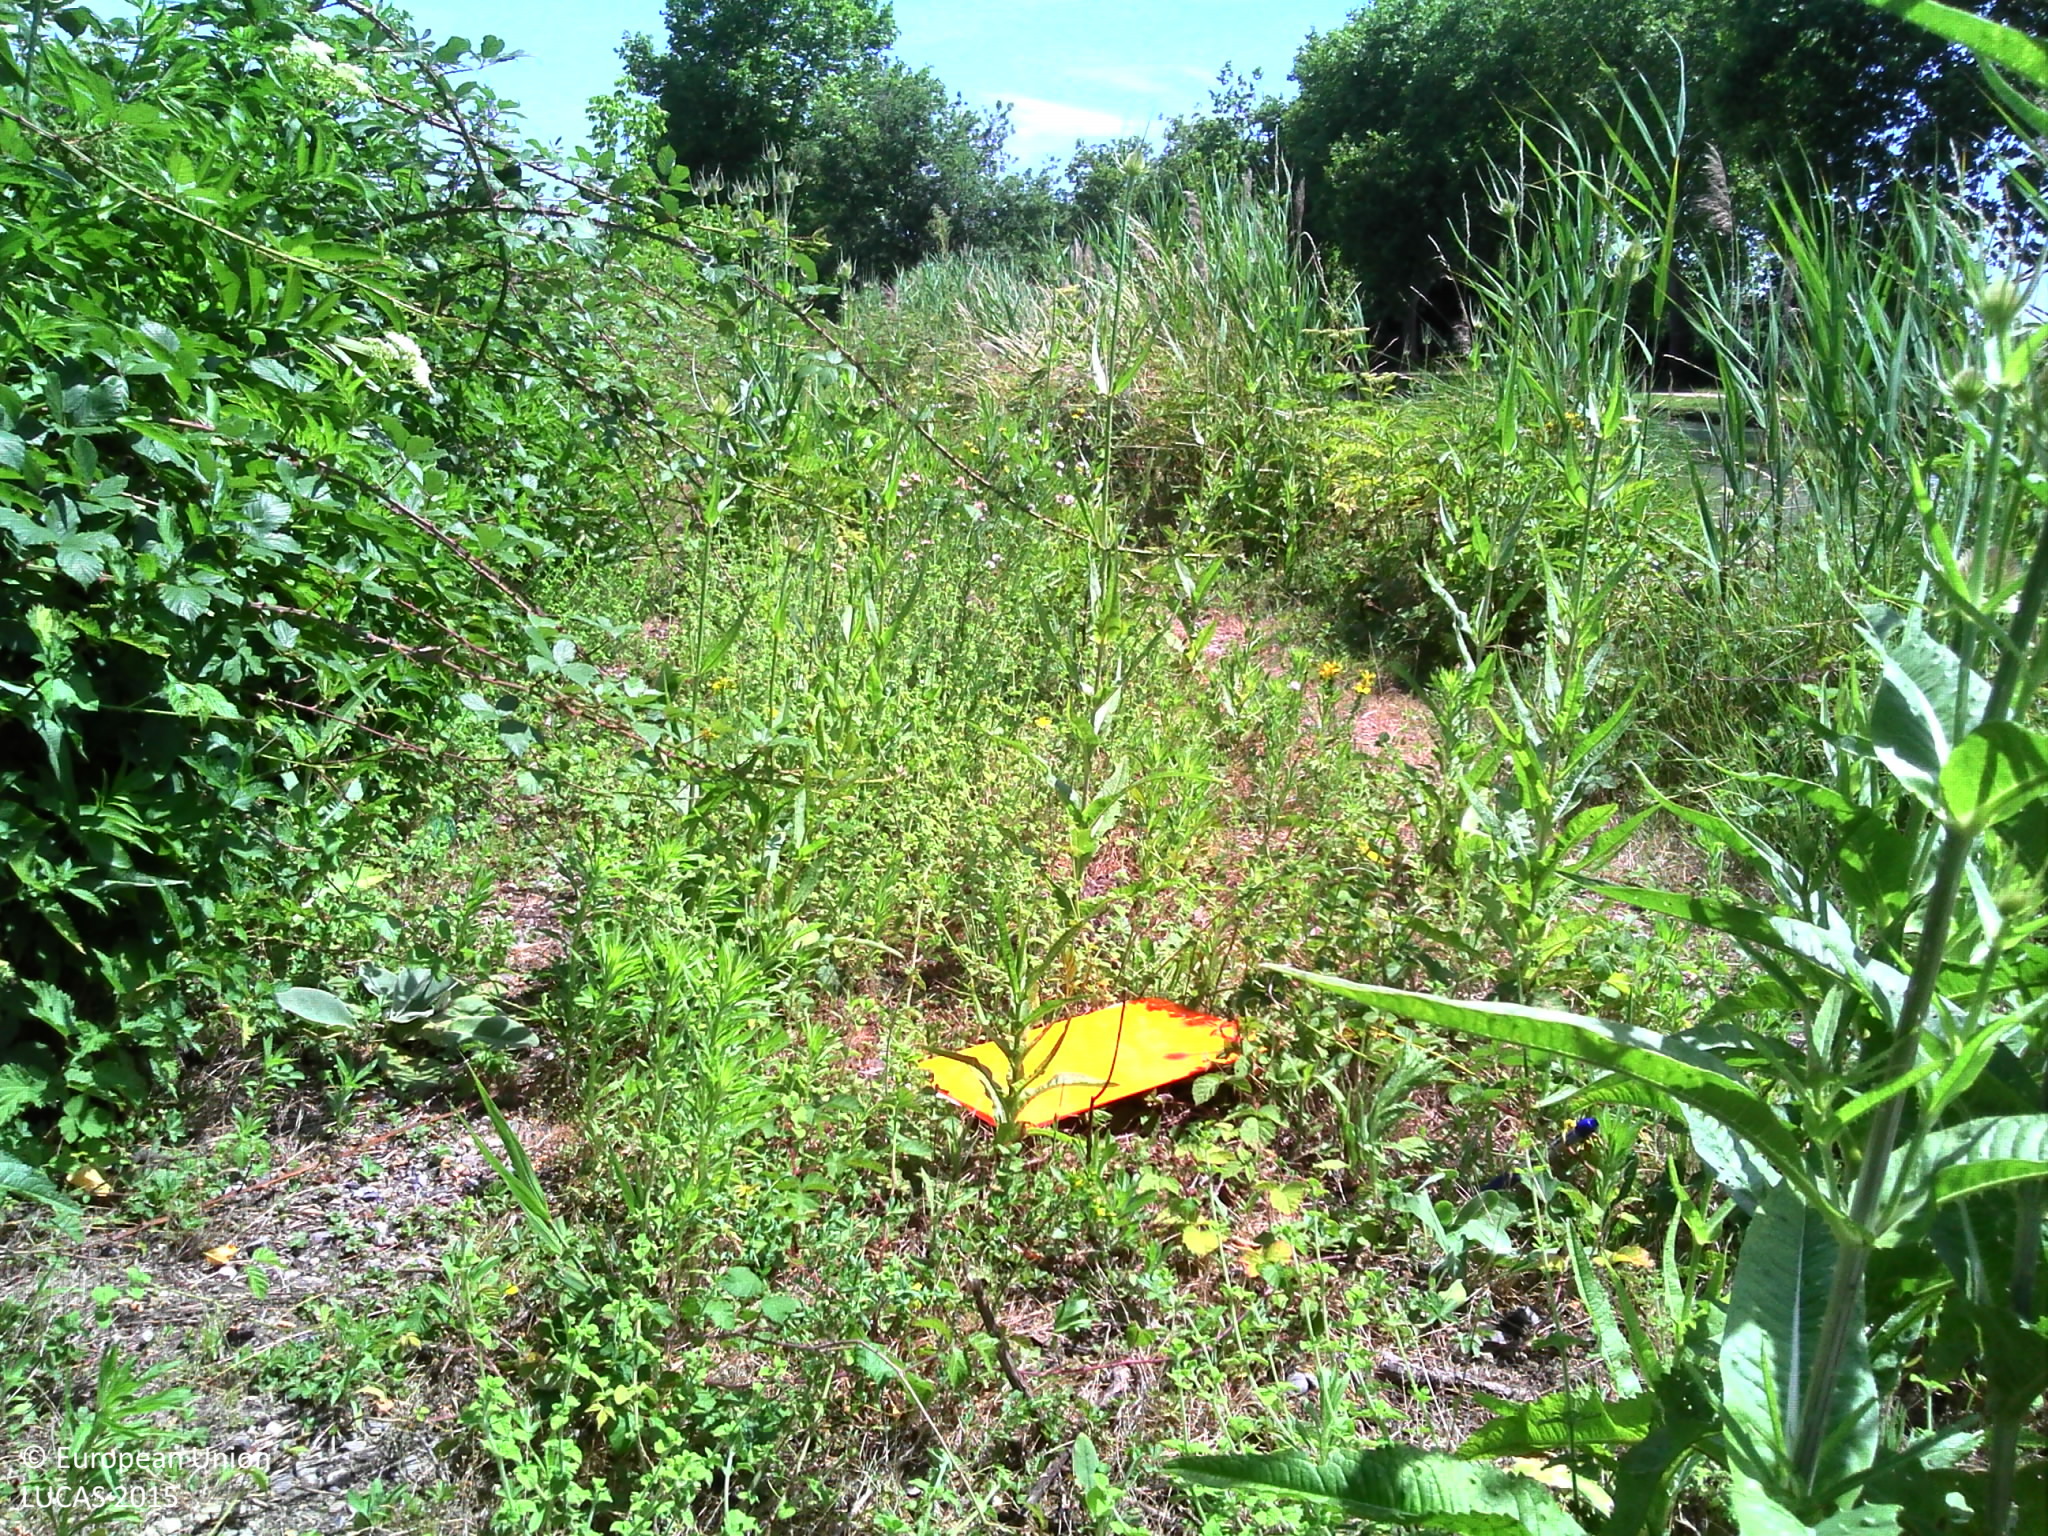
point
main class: Shrubland
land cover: Shrubland with sparse tree cover
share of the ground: > 75 %
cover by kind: shrubs 60 %, herbaceous plants 20 %, consolidated bare surface 15 %, broadleaved forest trees 5 %
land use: Semi-natural and natural areas not in use
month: June
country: FR
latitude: 43.7368
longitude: 1.3723
